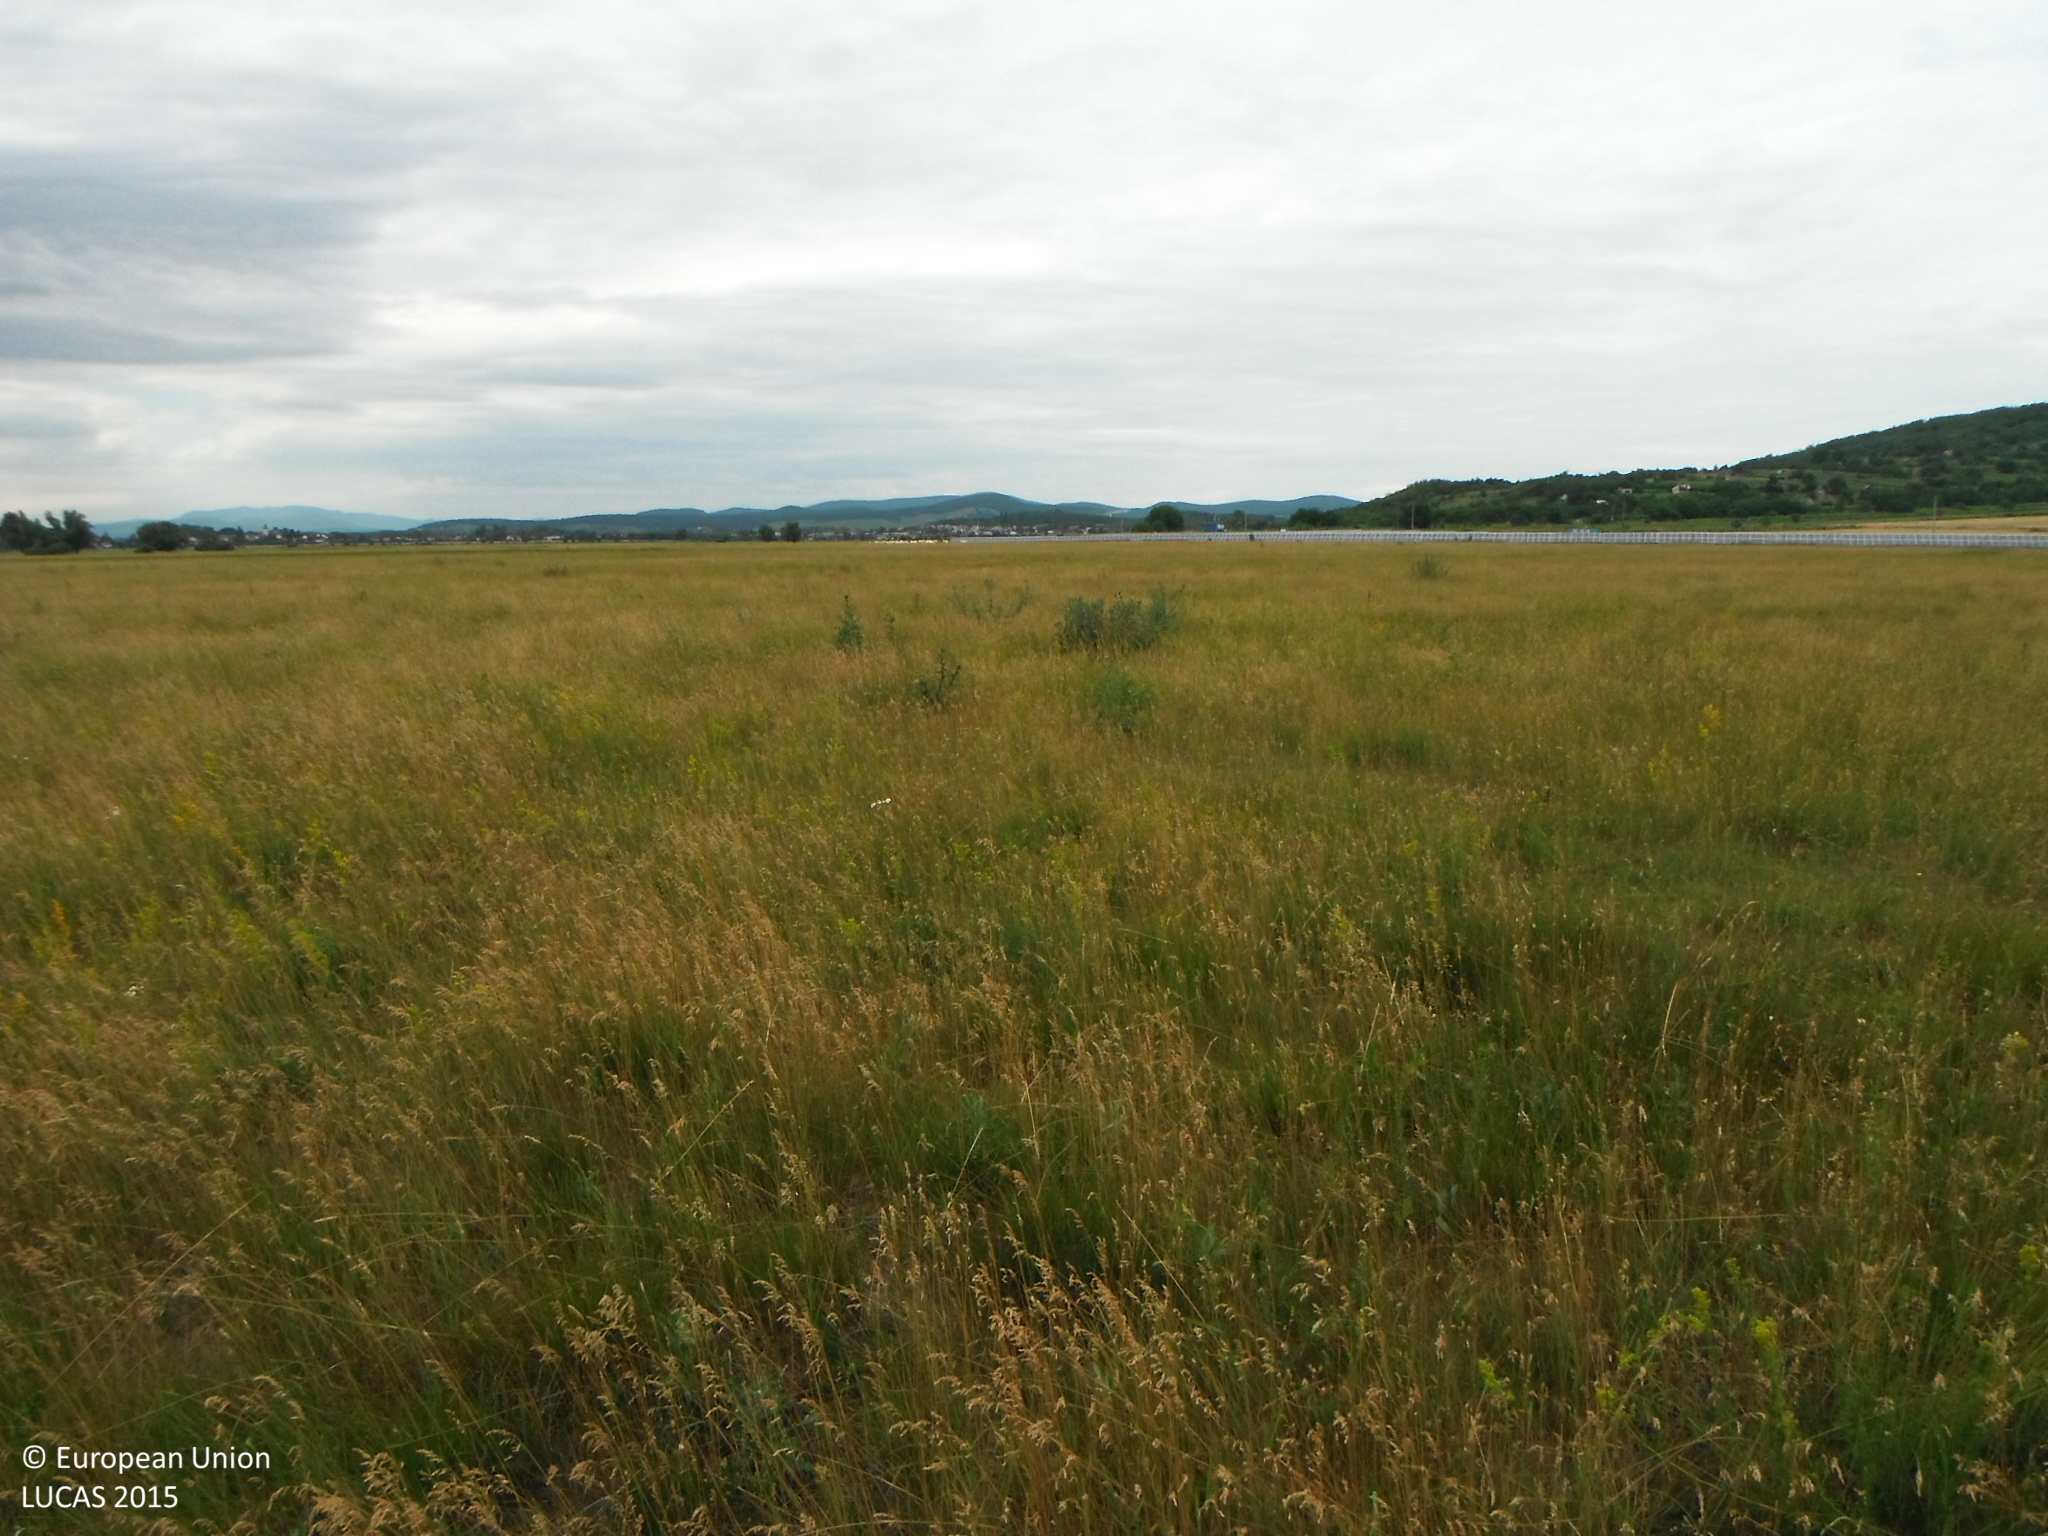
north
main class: Grassland
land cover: Grassland without tree/shrub cover
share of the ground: > 75 %
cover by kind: herbaceous plants 100 %
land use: Agriculture (excluding fallow land and kitchen gardens)
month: June
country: SK
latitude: 48.3534
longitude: 21.7773
